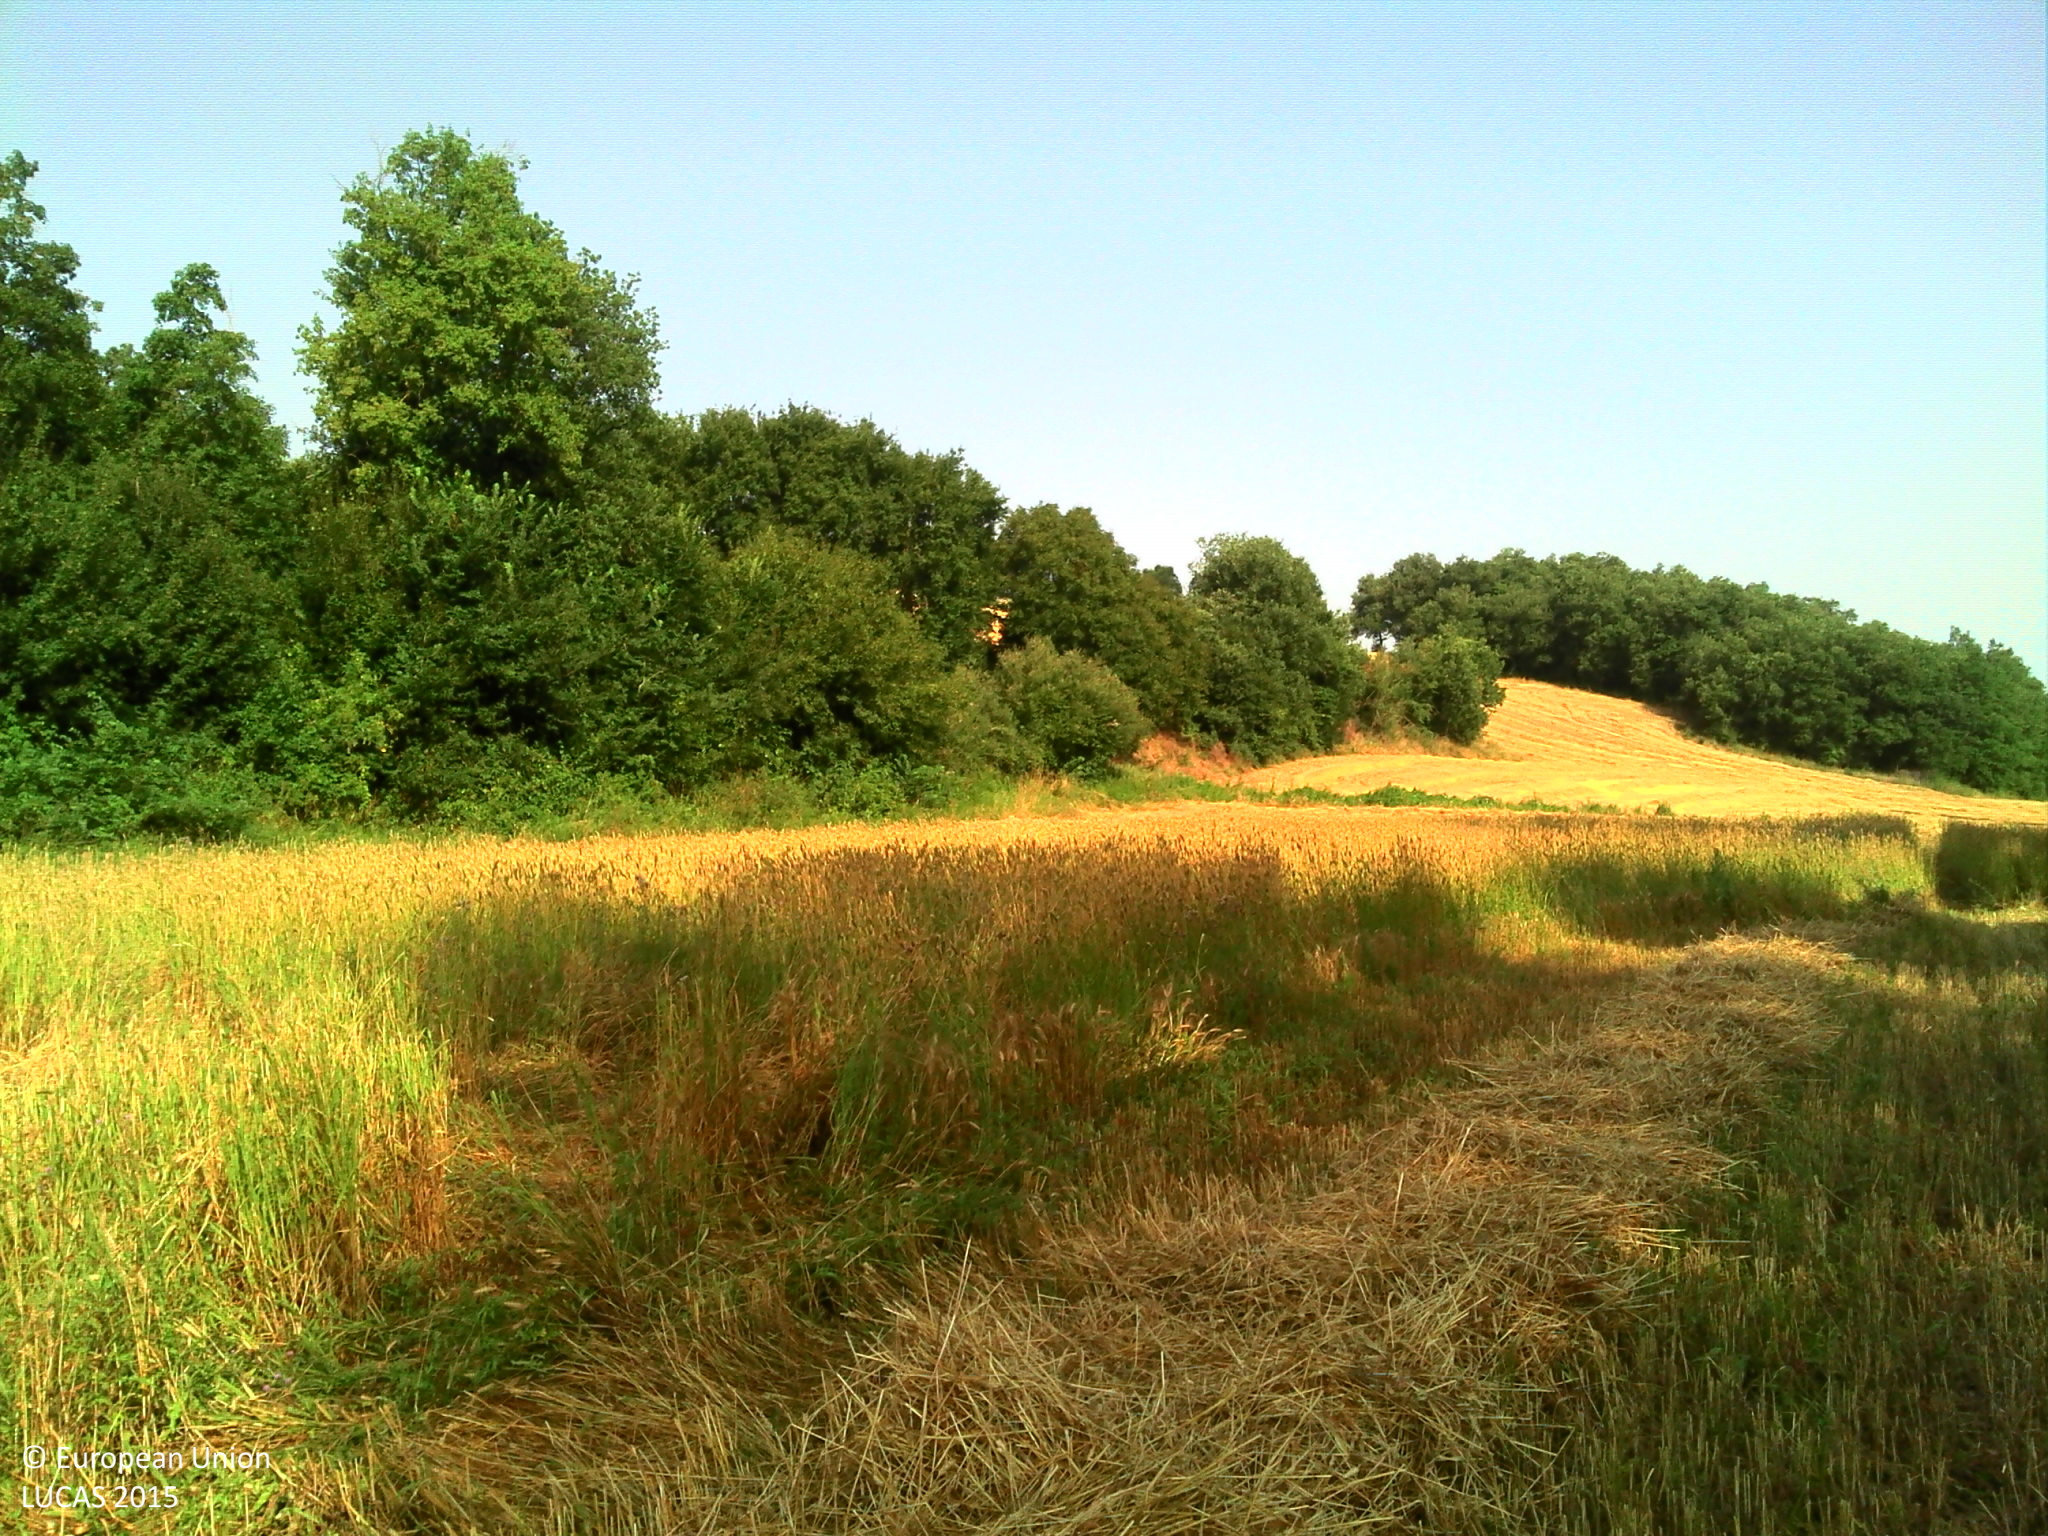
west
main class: Cropland
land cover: Durum wheat
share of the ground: > 75 %
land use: Agriculture (excluding fallow land and kitchen gardens)
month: July
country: FR
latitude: 43.2490
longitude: 1.3951
